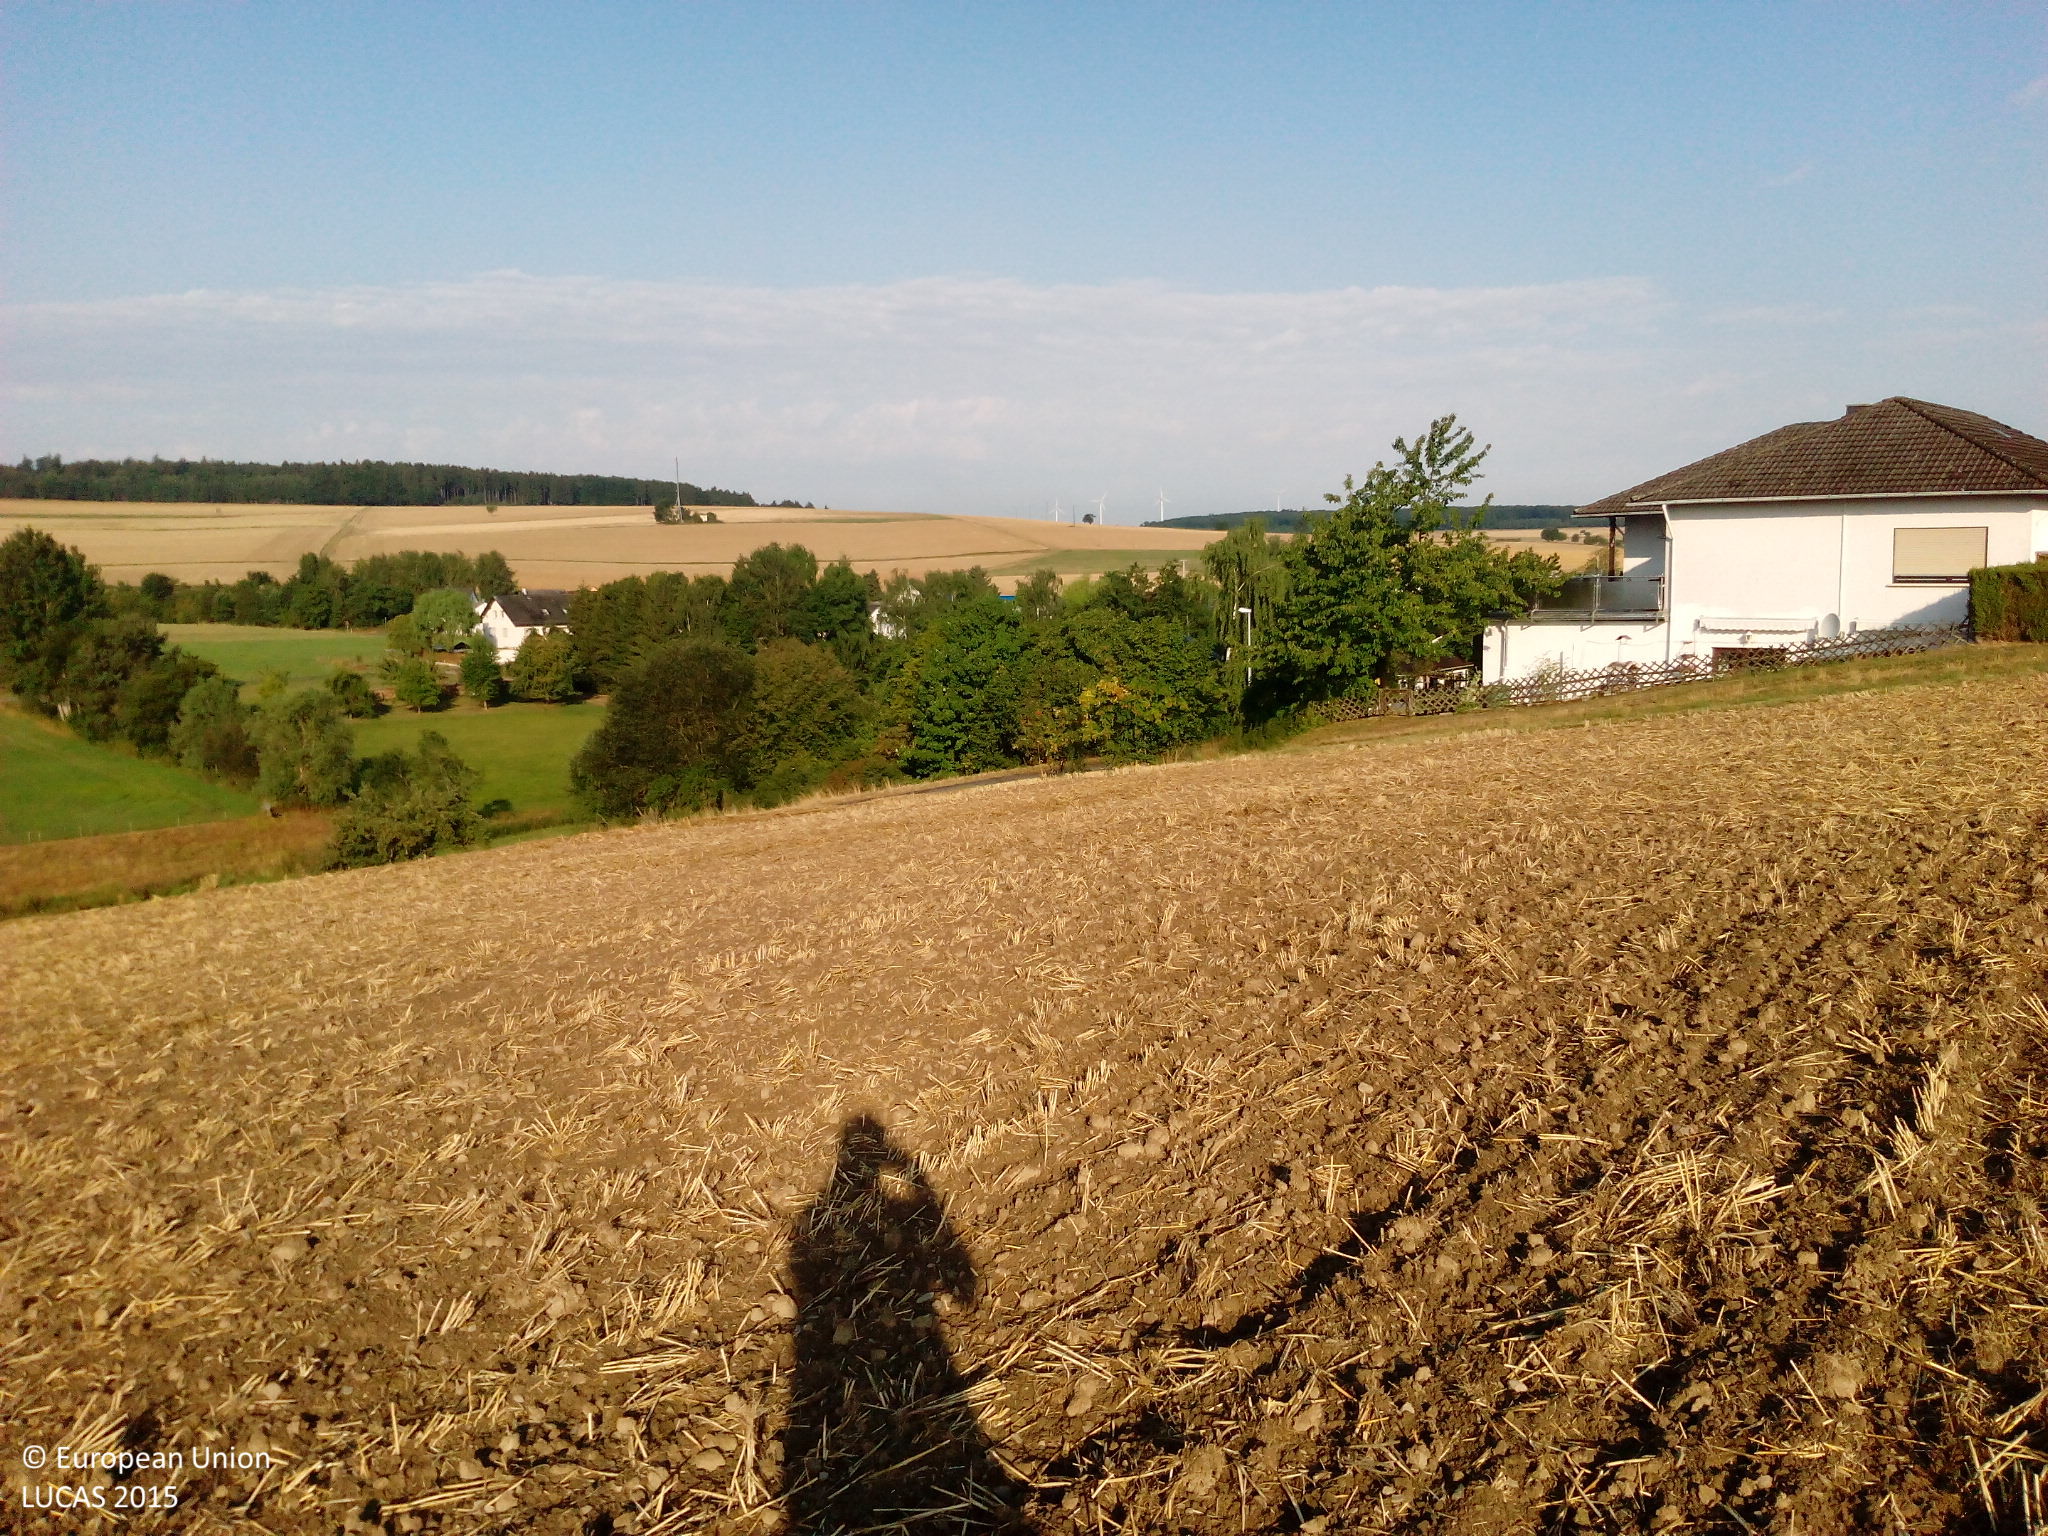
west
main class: Cropland
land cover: Common wheat
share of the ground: < 10 %
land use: Agriculture (excluding fallow land and kitchen gardens)
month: August
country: DE
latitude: 50.2391
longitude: 8.0234
